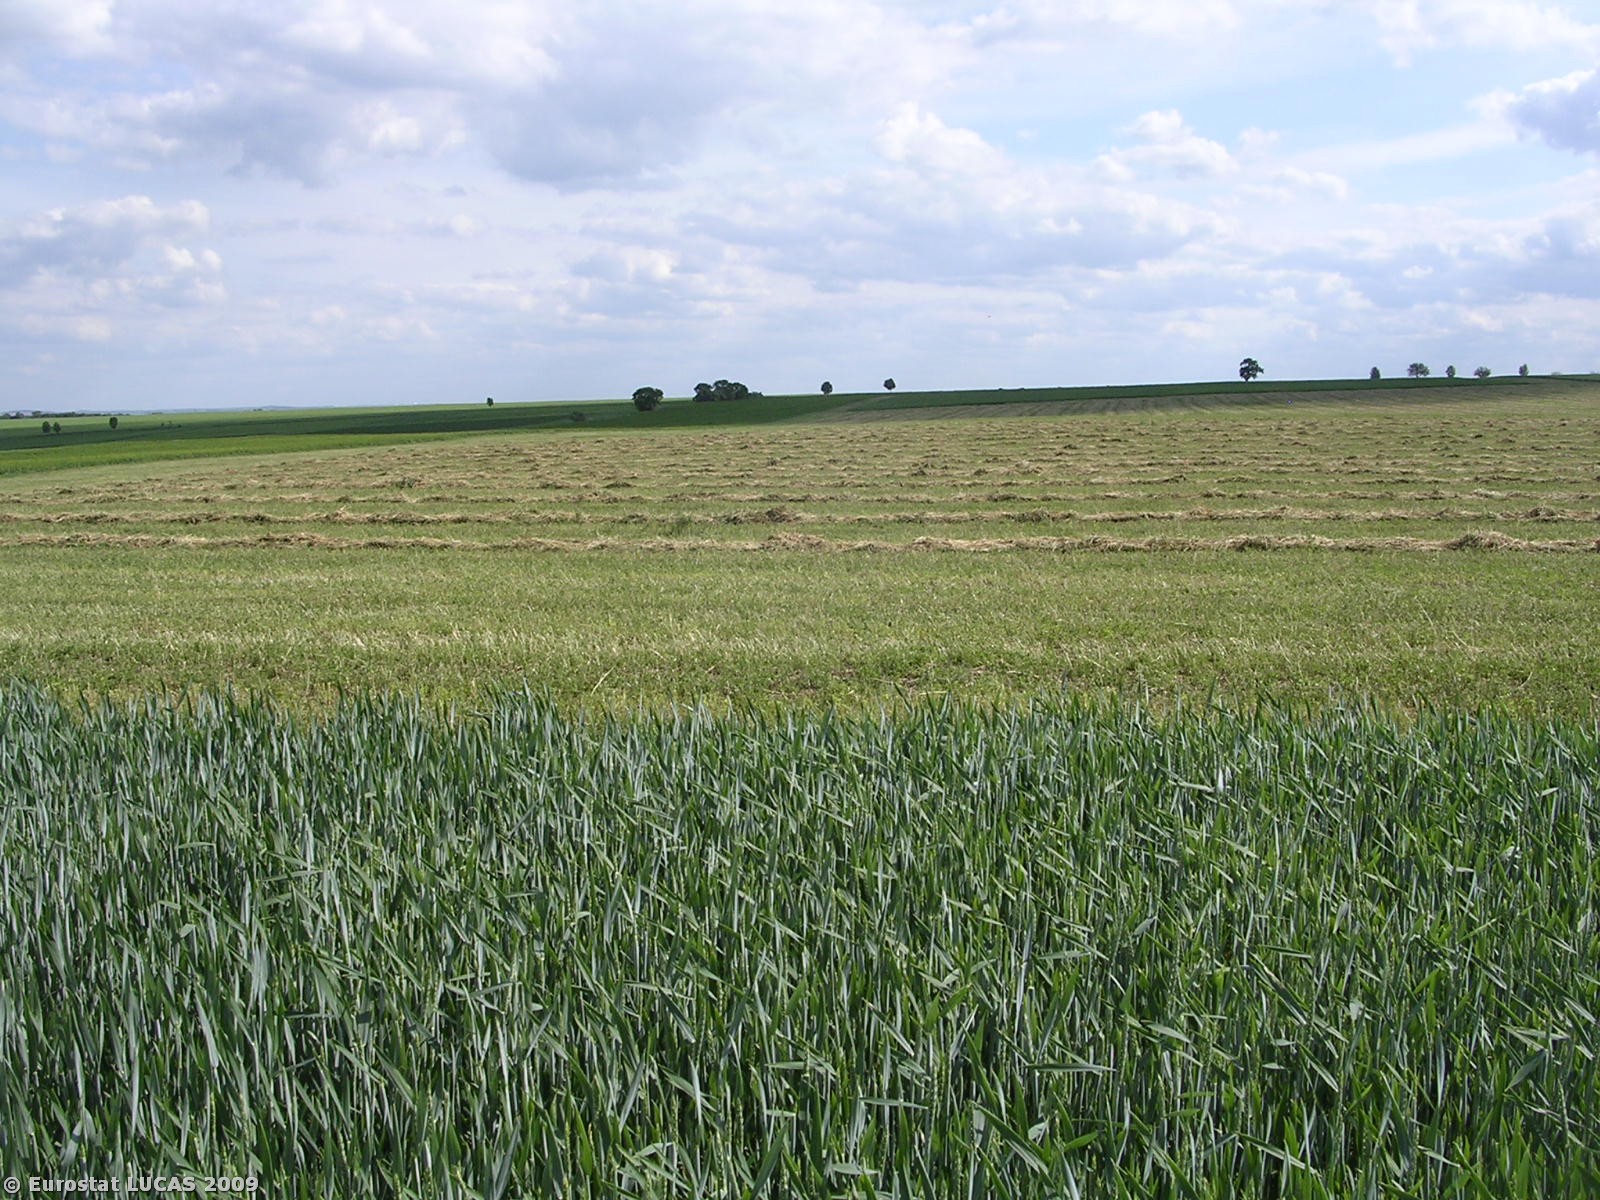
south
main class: Cropland
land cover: Common wheat
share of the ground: > 75 %
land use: Agriculture (excluding fallow land and kitchen gardens)
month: May
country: CZ
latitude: 50.3778
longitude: 14.1776
